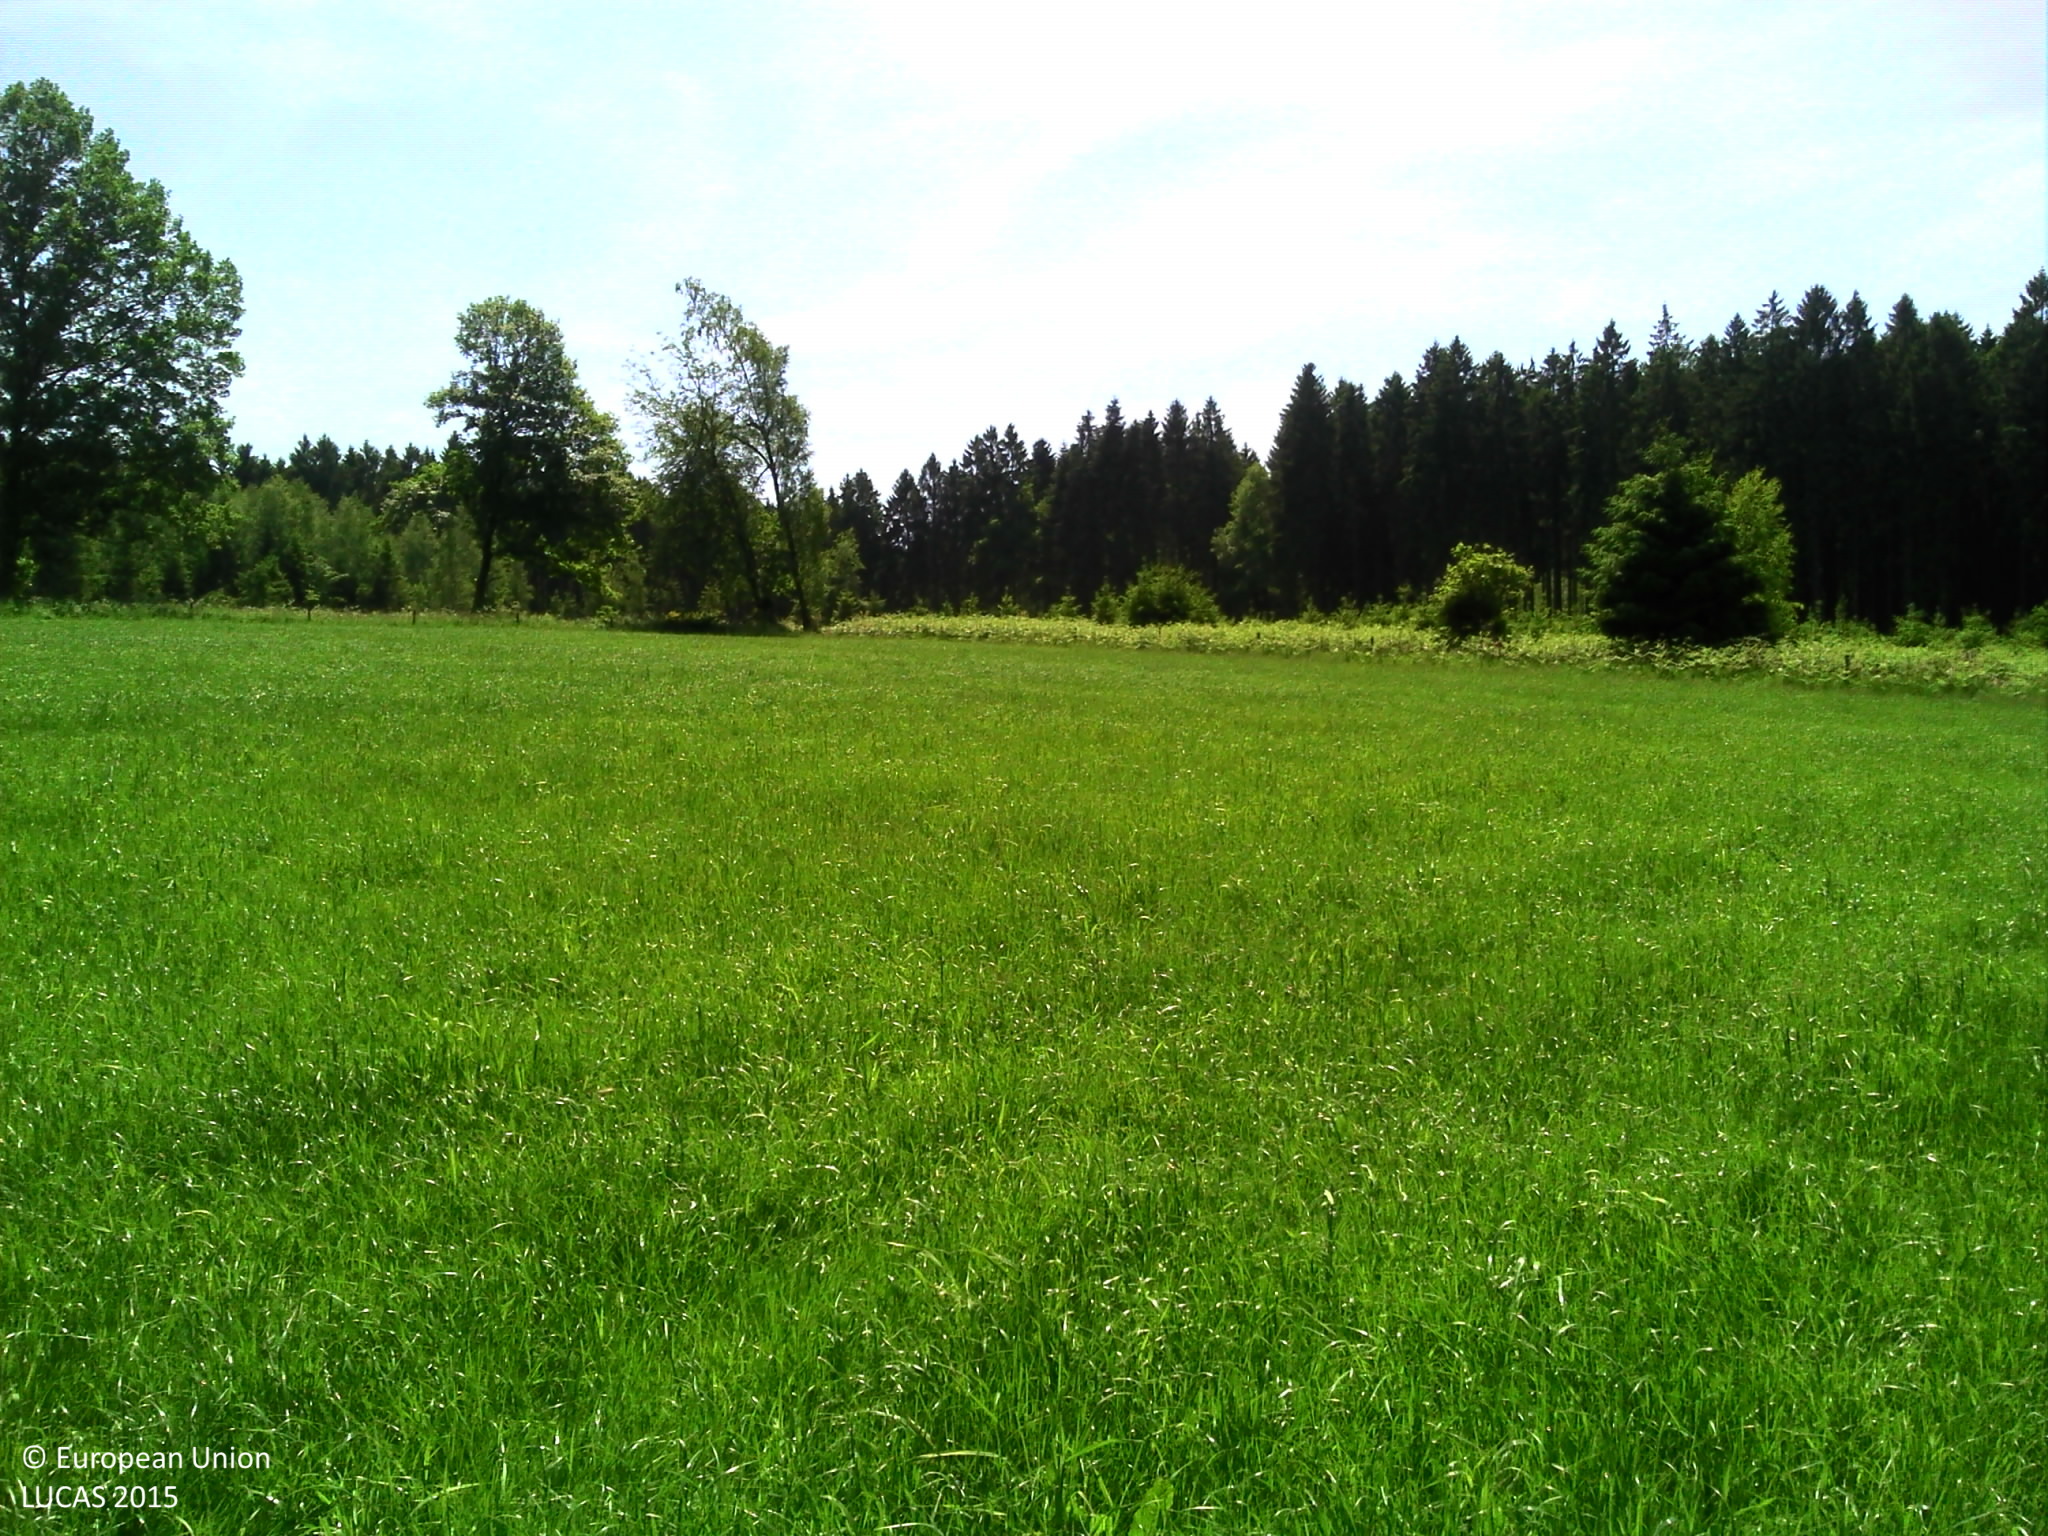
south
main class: Grassland
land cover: Grassland without tree/shrub cover
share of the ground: > 75 %
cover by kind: herbaceous plants 100 %
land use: Agriculture (excluding fallow land and kitchen gardens)
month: June
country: BE
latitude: 50.4834
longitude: 5.7565
